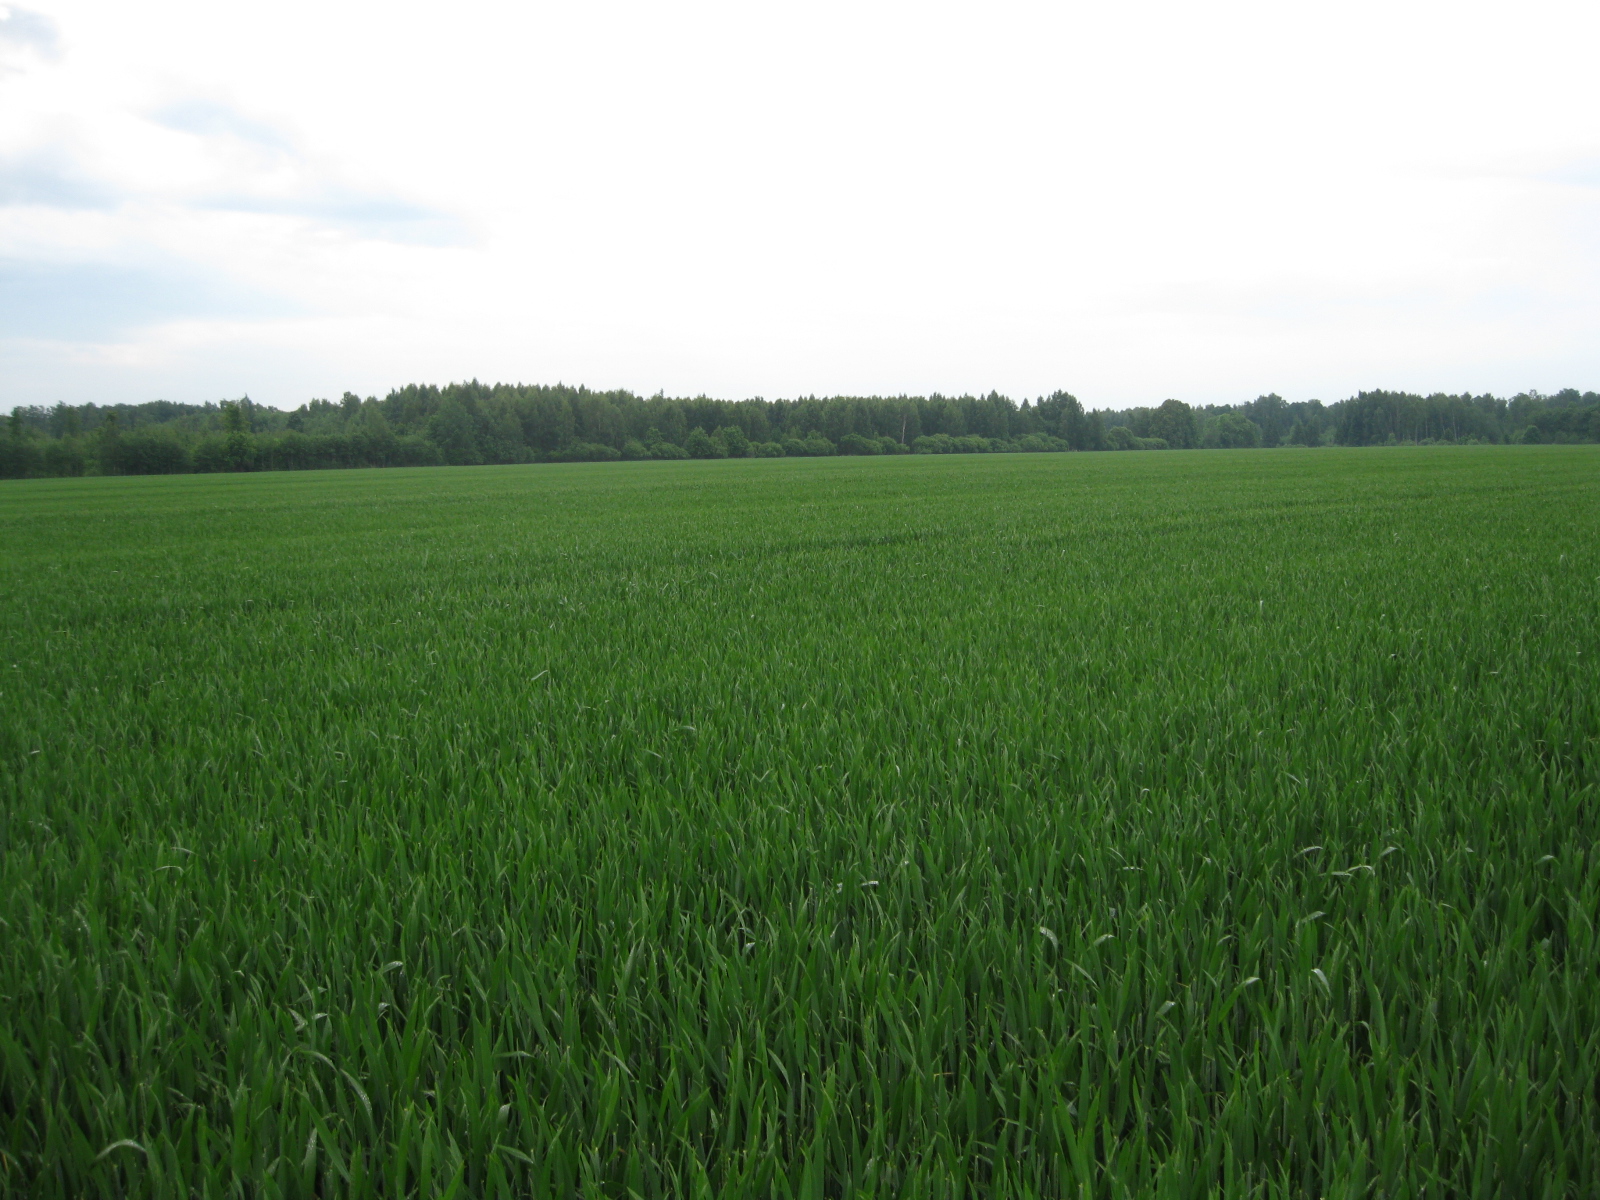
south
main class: Cropland
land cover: Common wheat
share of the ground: > 75 %
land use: Agriculture (excluding fallow land and kitchen gardens)
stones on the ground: < 10 %
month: June
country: LT
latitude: 55.6322
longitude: 24.0194
